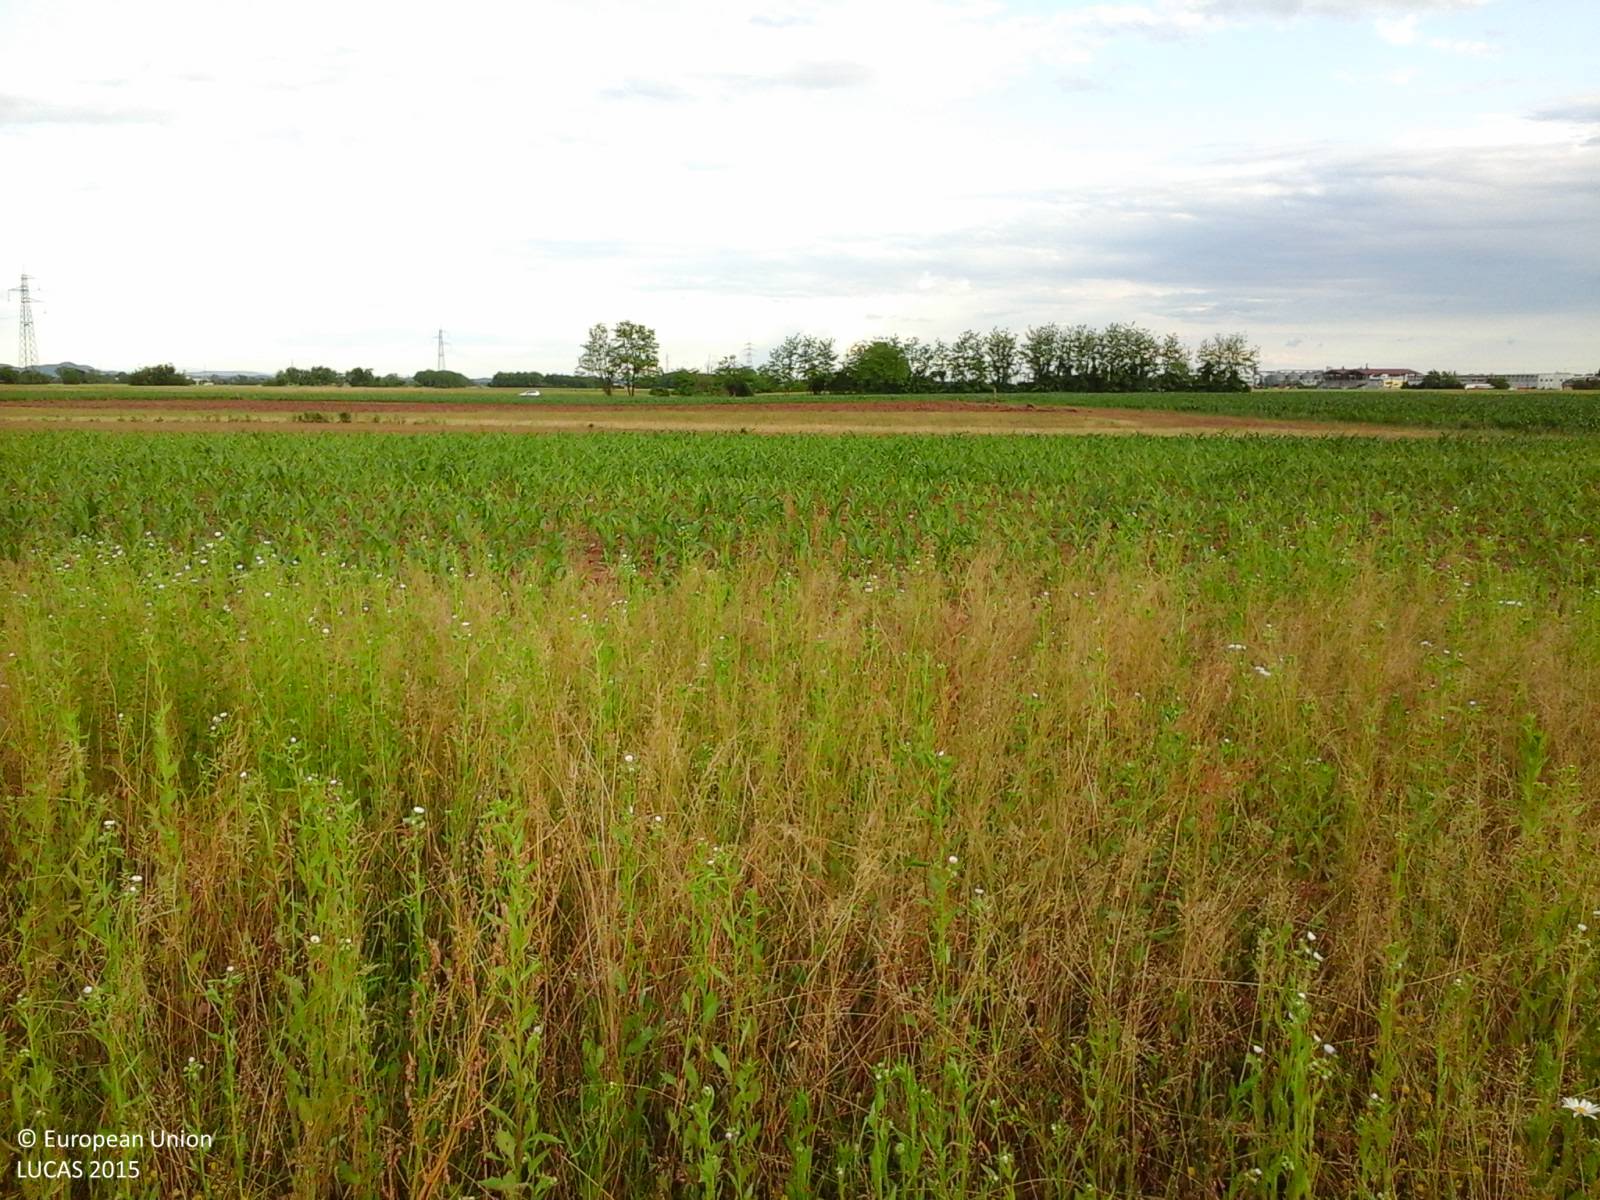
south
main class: Grassland
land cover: Spontaneously vegetated surfaces
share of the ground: > 75 %
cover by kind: herbaceous plants 100 %
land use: Fallow land
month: May
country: IT
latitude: 46.1022
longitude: 13.2952
